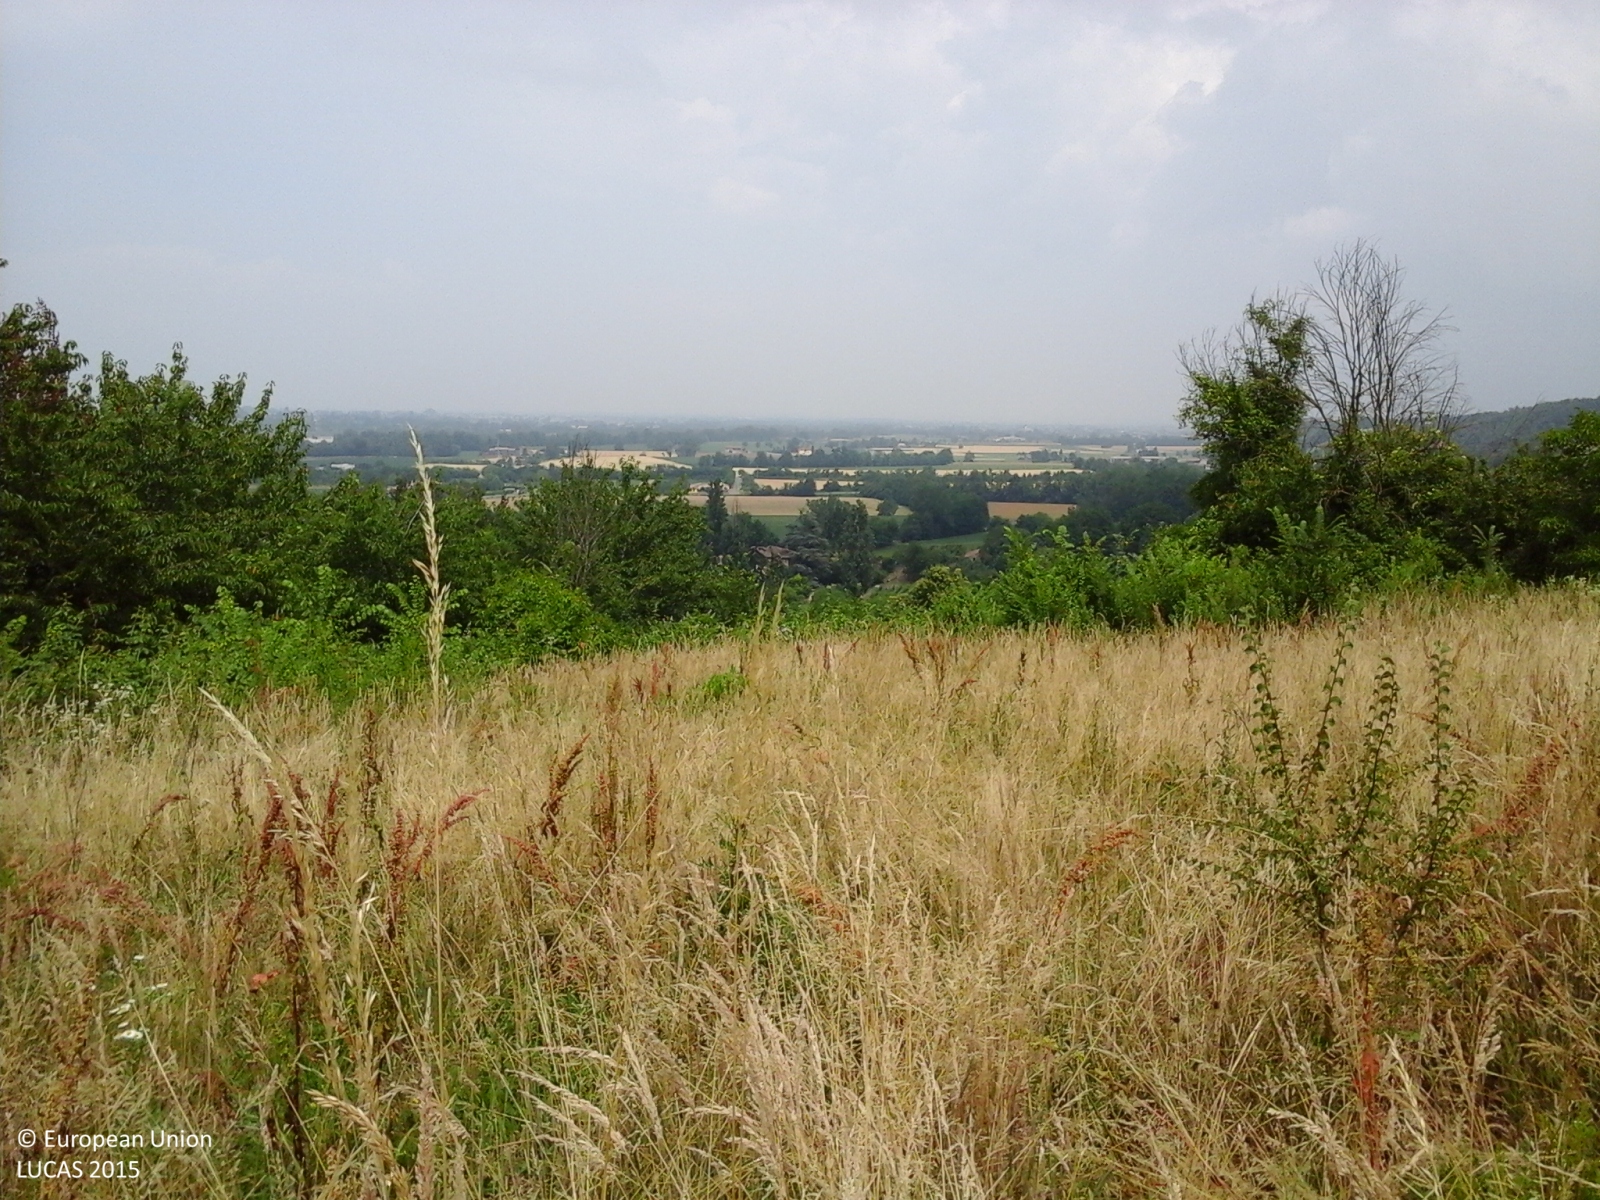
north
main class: Grassland
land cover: Grassland without tree/shrub cover
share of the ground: > 75 %
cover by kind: herbaceous plants 100 %
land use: Agriculture (excluding fallow land and kitchen gardens)
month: June
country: IT
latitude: 44.8730
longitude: 9.6589
